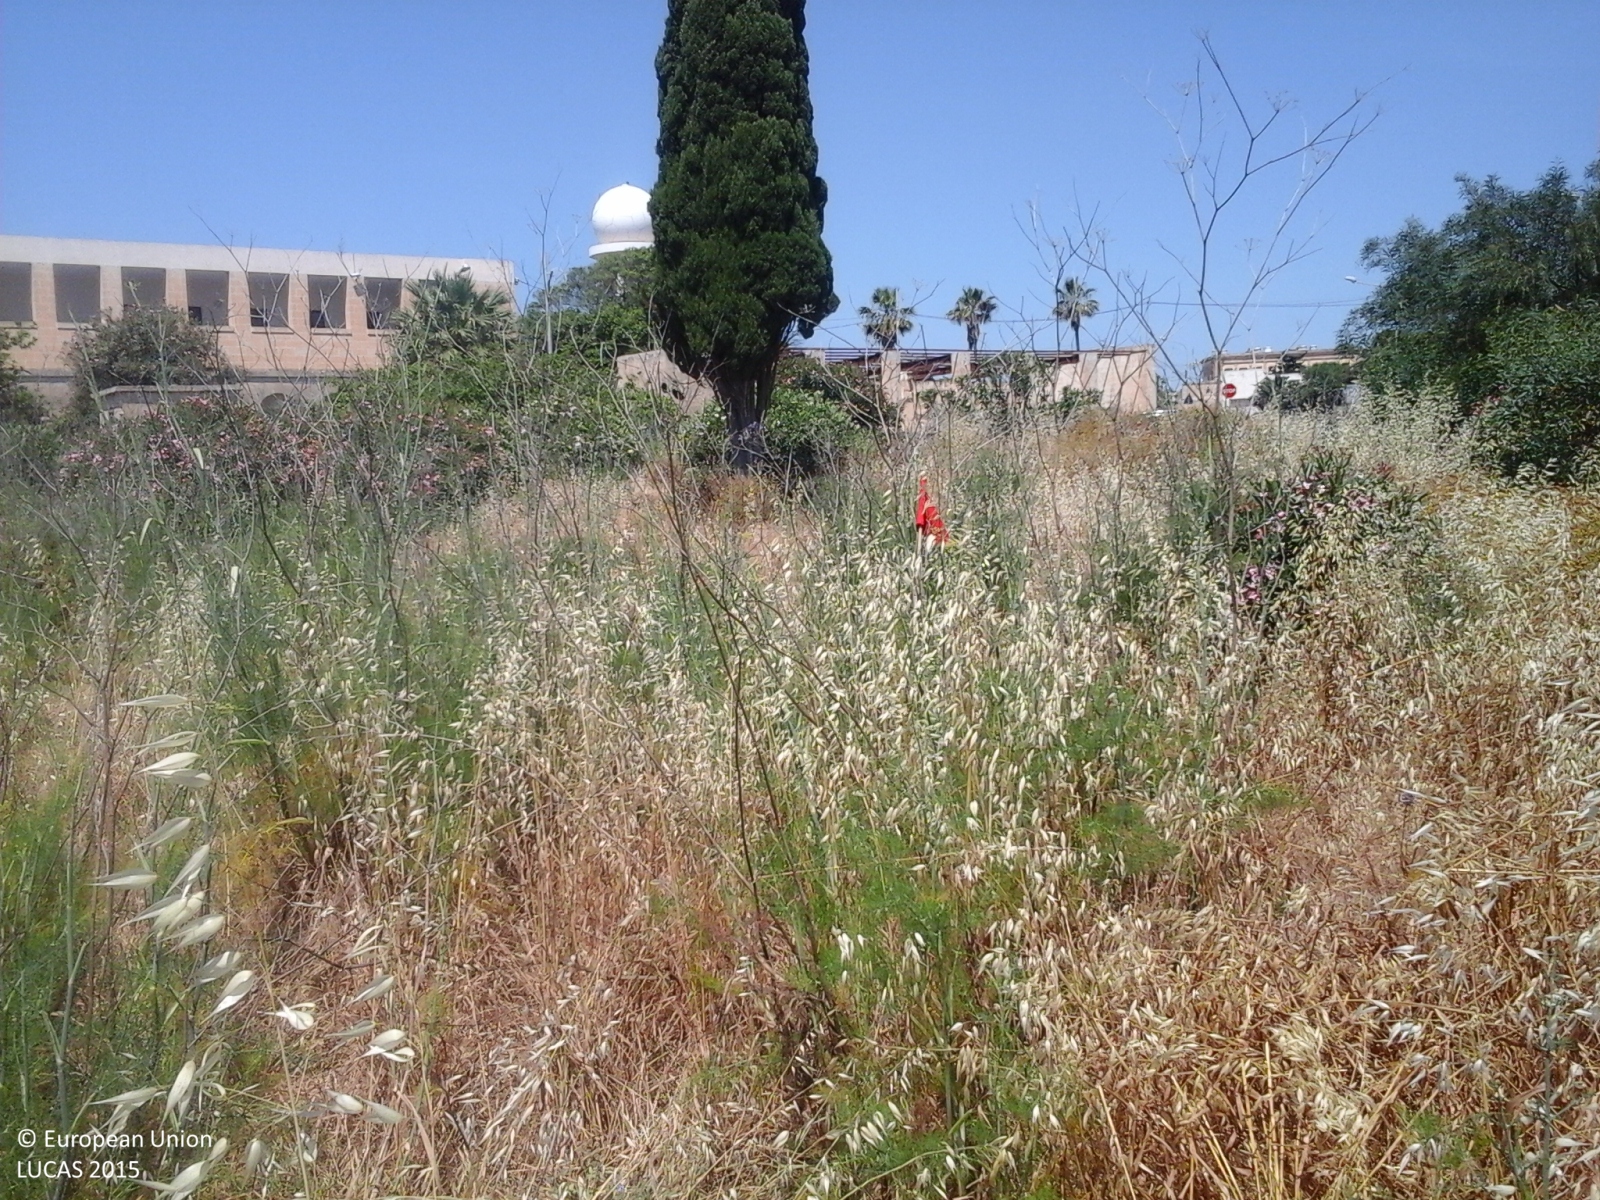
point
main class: Grassland
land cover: Grassland with sparse tree/shrub cover
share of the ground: > 75 %
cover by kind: herbaceous plants 95 %, coniferous forest trees 5 %
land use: Abandoned areas
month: May
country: MT
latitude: 35.8208
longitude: 14.5071
